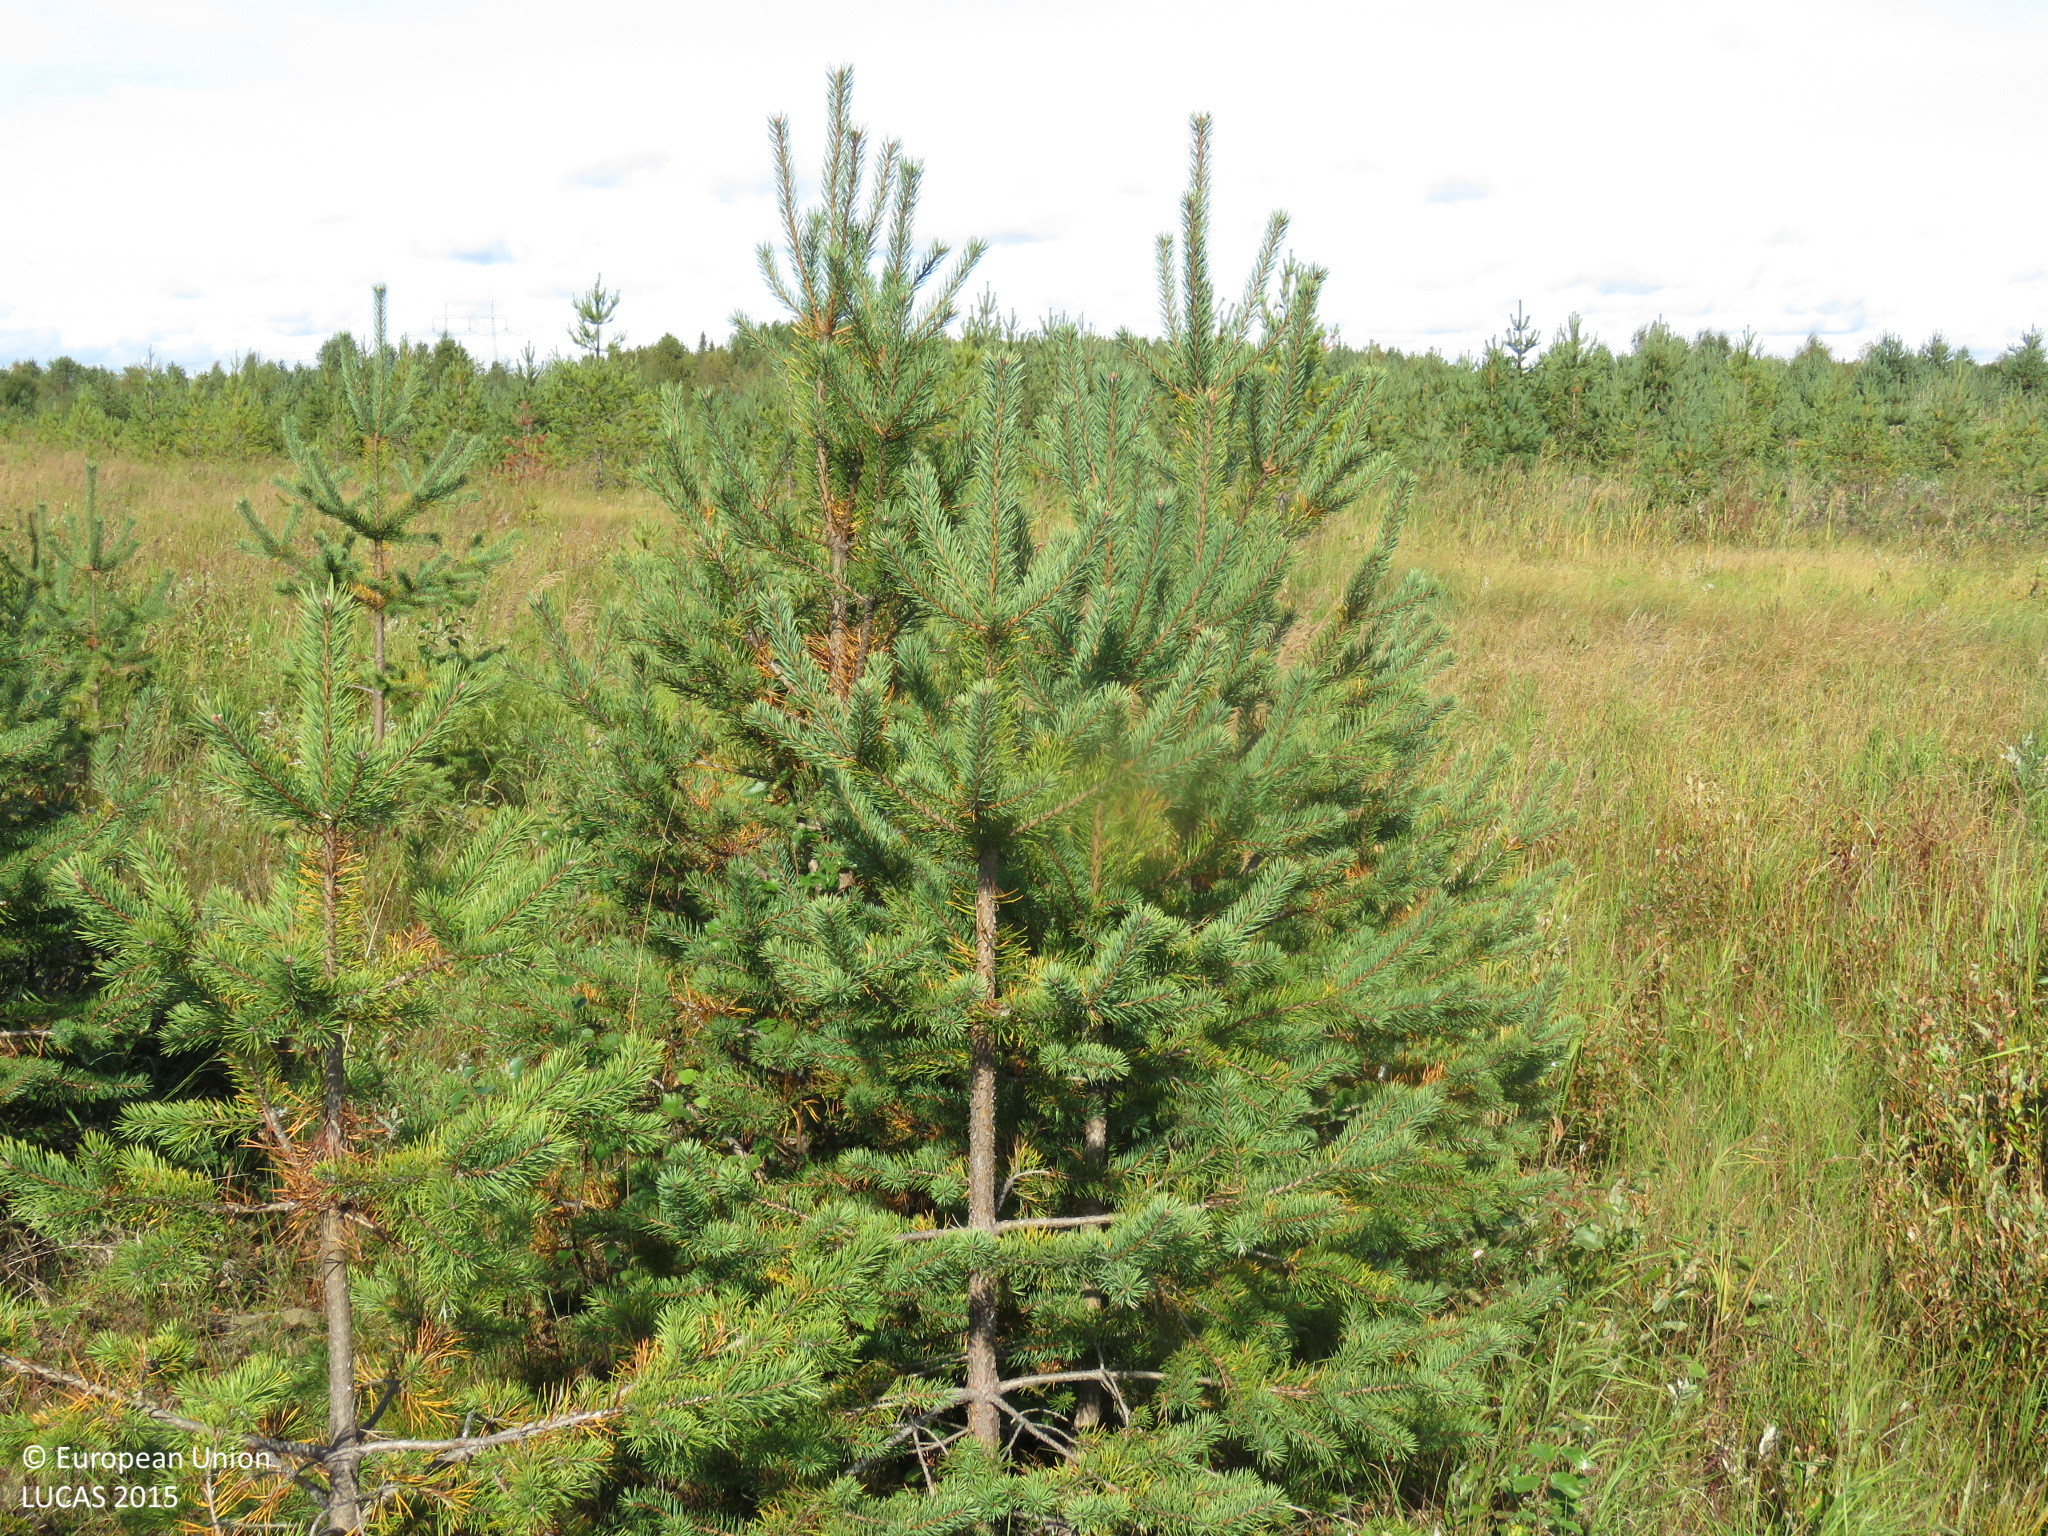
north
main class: Woodland
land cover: Pine dominated mixed woodland
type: mire and swamp forests
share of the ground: 10 - 25 %
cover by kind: unconsolidated bare surface 50 %, herbaceous plants 30 %, coniferous forest trees 10 %, broadleaved forest trees 5 %, lichens and mosses 5 %
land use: Abandoned areas
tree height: < 5 m
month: August
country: FI
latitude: 65.2770
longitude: 26.0576
